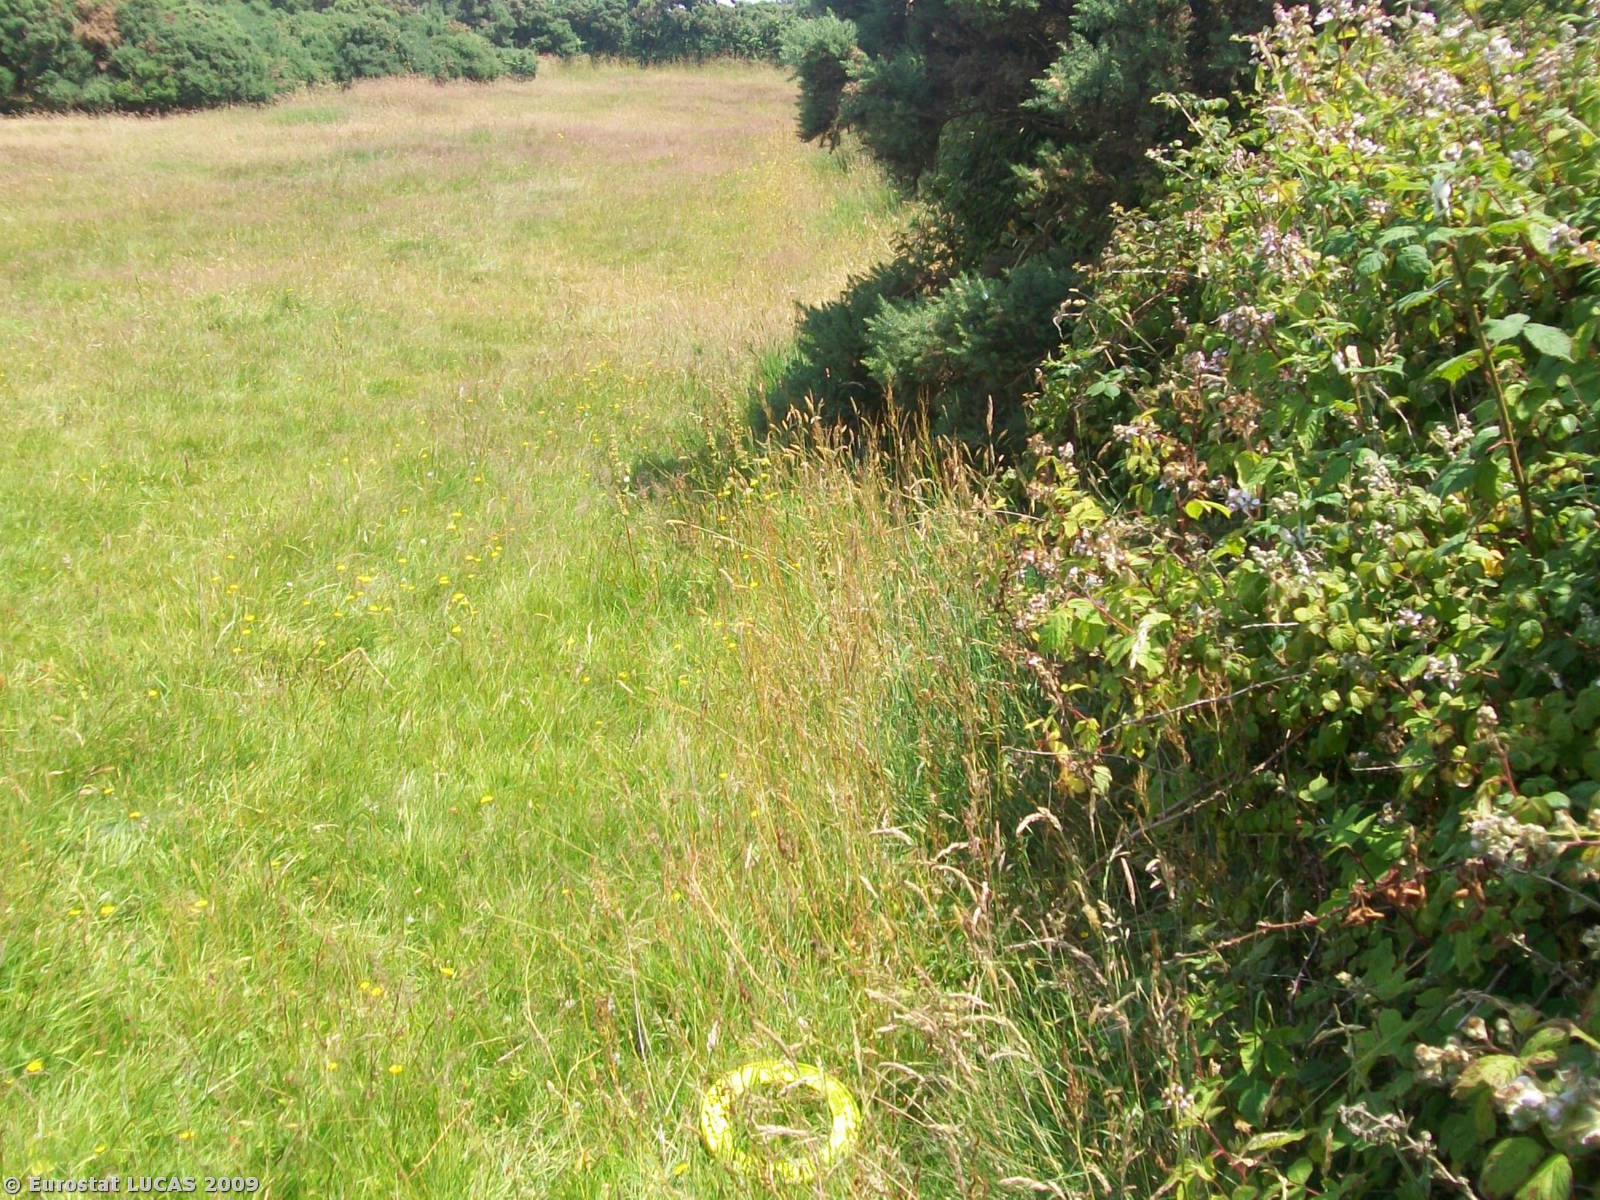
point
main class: Grassland
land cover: Grassland without tree/shrub cover
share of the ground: > 75 %
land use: Agriculture (excluding fallow land and kitchen gardens)
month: July
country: GB
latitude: 50.2243
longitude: -5.1591
